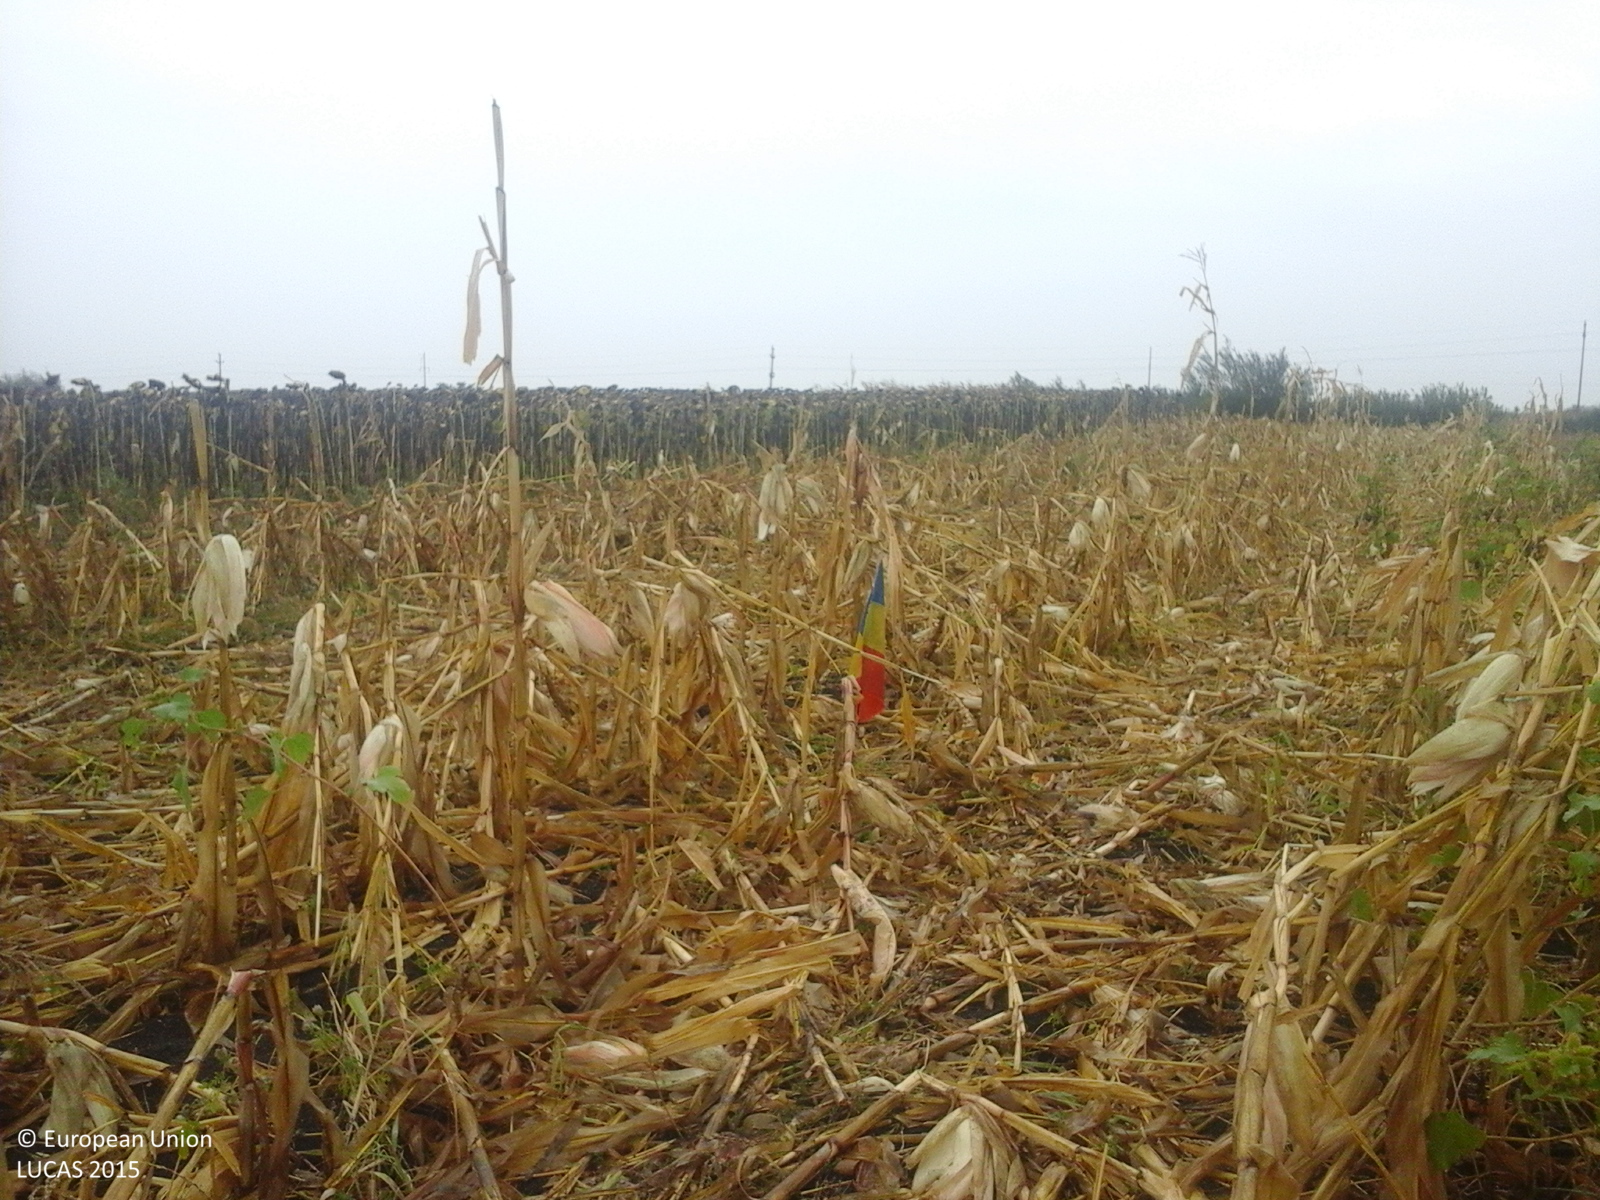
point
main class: Cropland
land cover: Maize
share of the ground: > 75 %
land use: Agriculture (excluding fallow land and kitchen gardens)
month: September
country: RO
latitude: 47.6152
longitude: 22.5241
